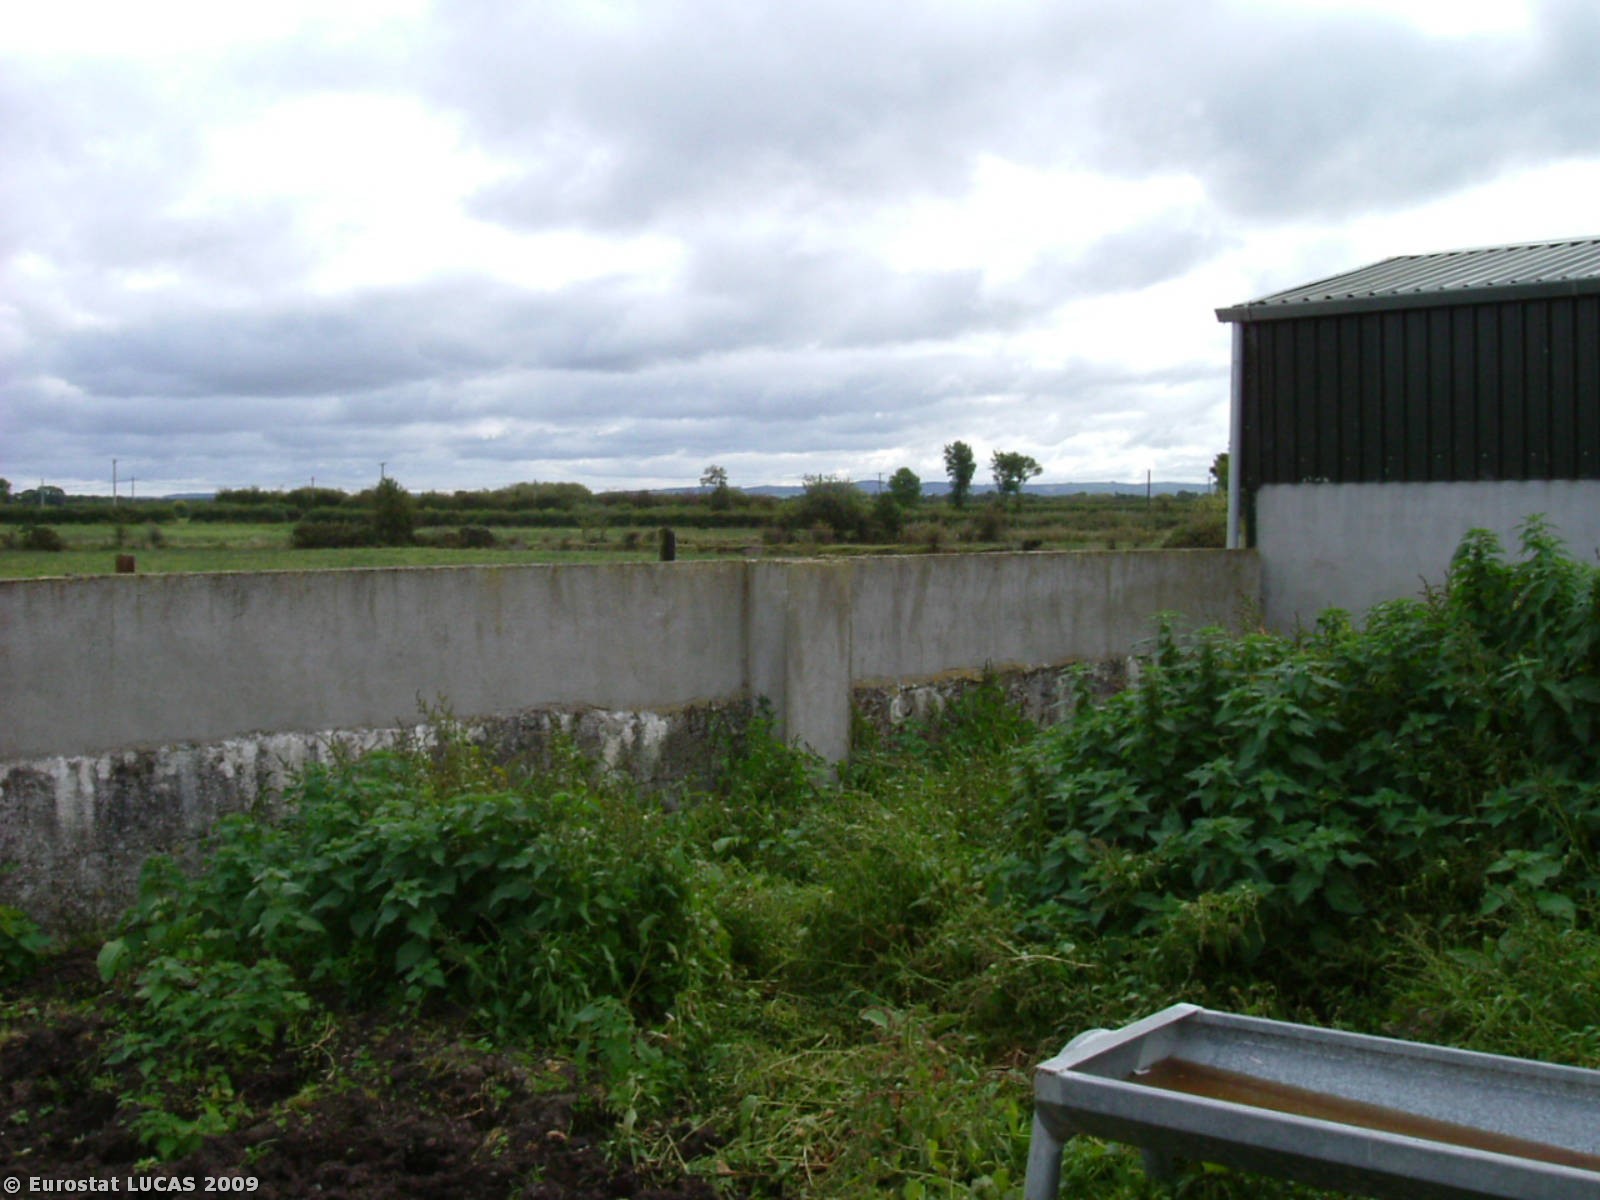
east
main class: Grassland
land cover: Spontaneously vegetated surfaces
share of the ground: > 75 %
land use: Fallow land
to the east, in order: Spontaneously vegetated surfaces; Fences; Grassland without tree/shrub cover; Managed hedges; Grassland without tree/shrub cover
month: October
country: IE
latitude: 52.7258
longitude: -7.7121
